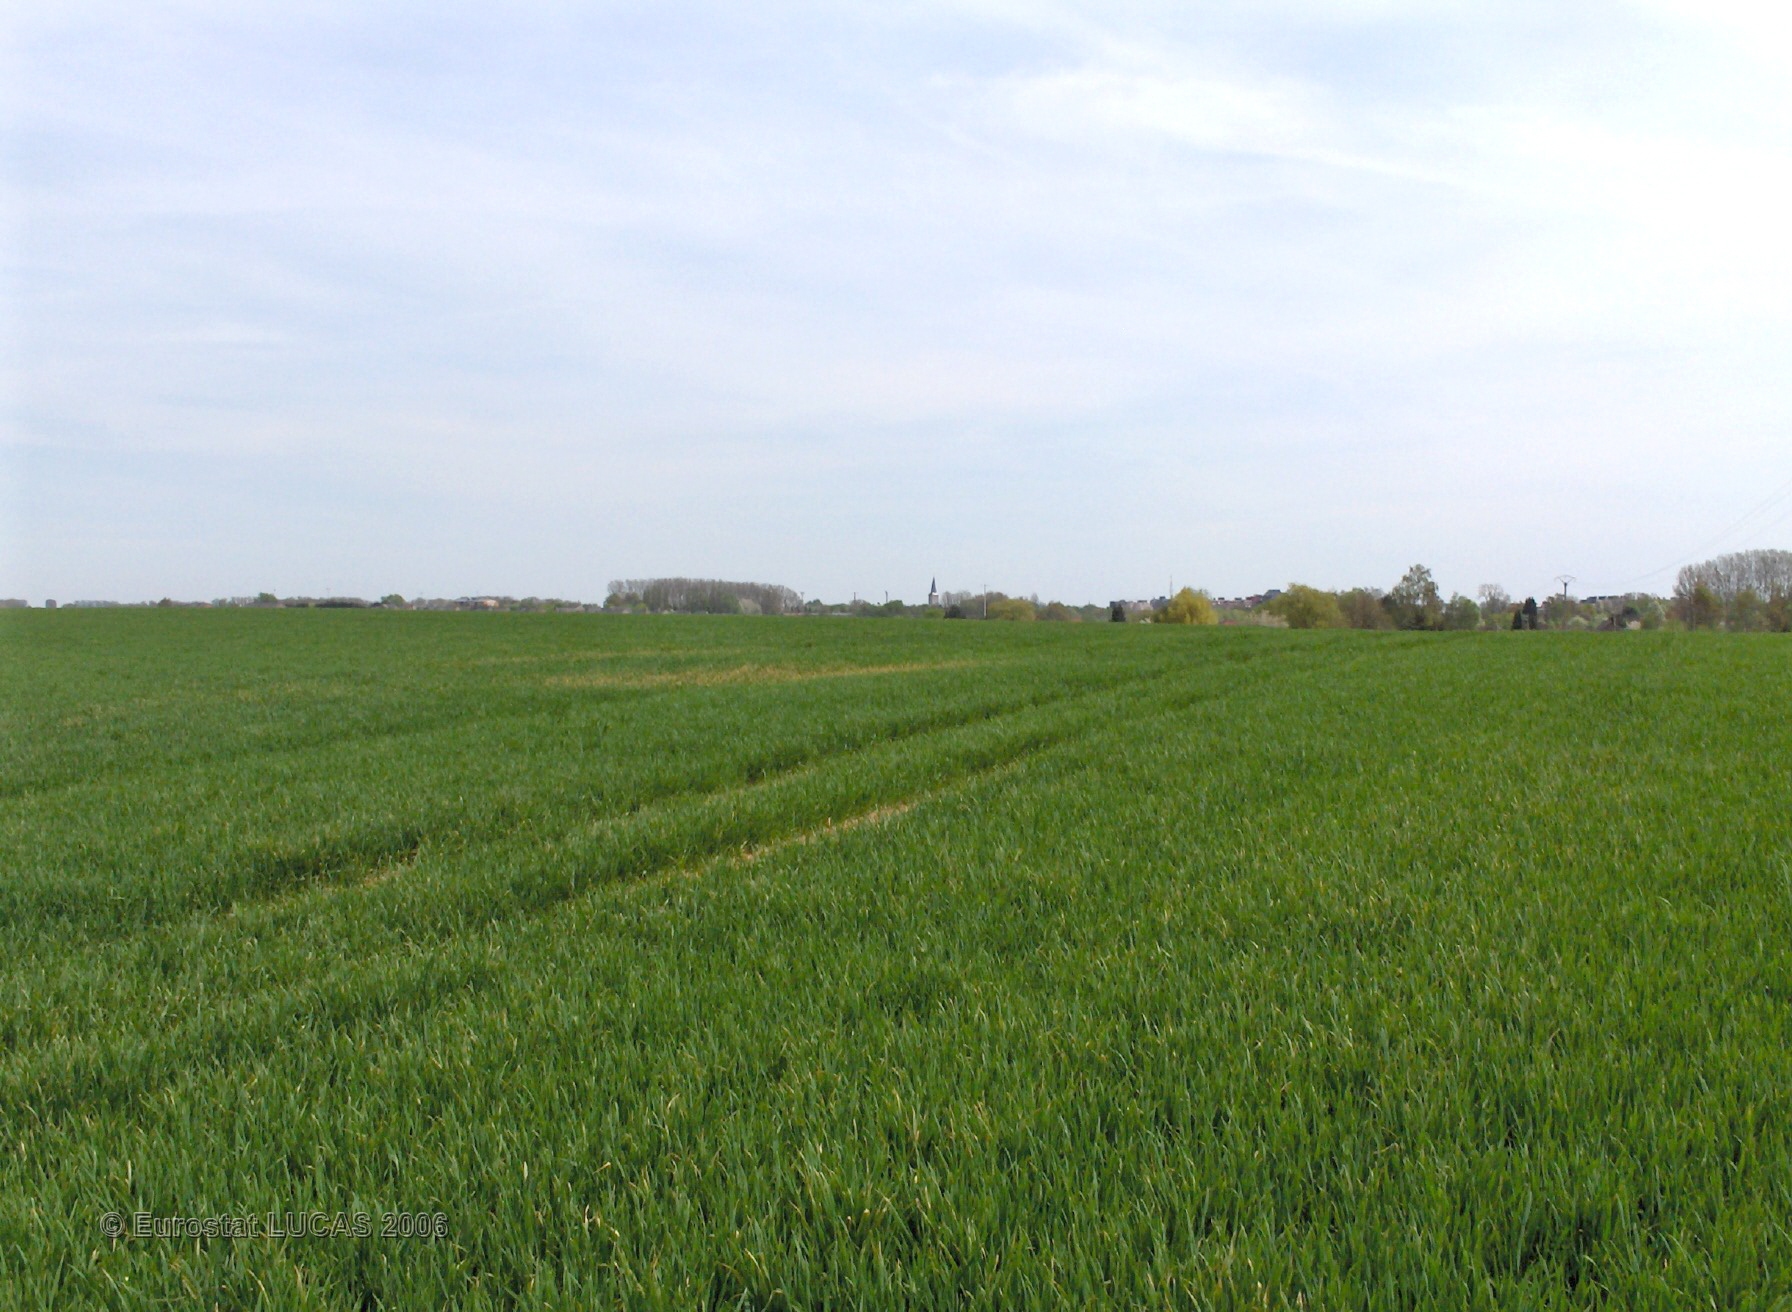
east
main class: Cropland
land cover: Common wheat
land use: Agriculture (excluding fallow land and kitchen gardens)
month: May
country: BE
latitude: 50.6968
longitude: 5.2266
